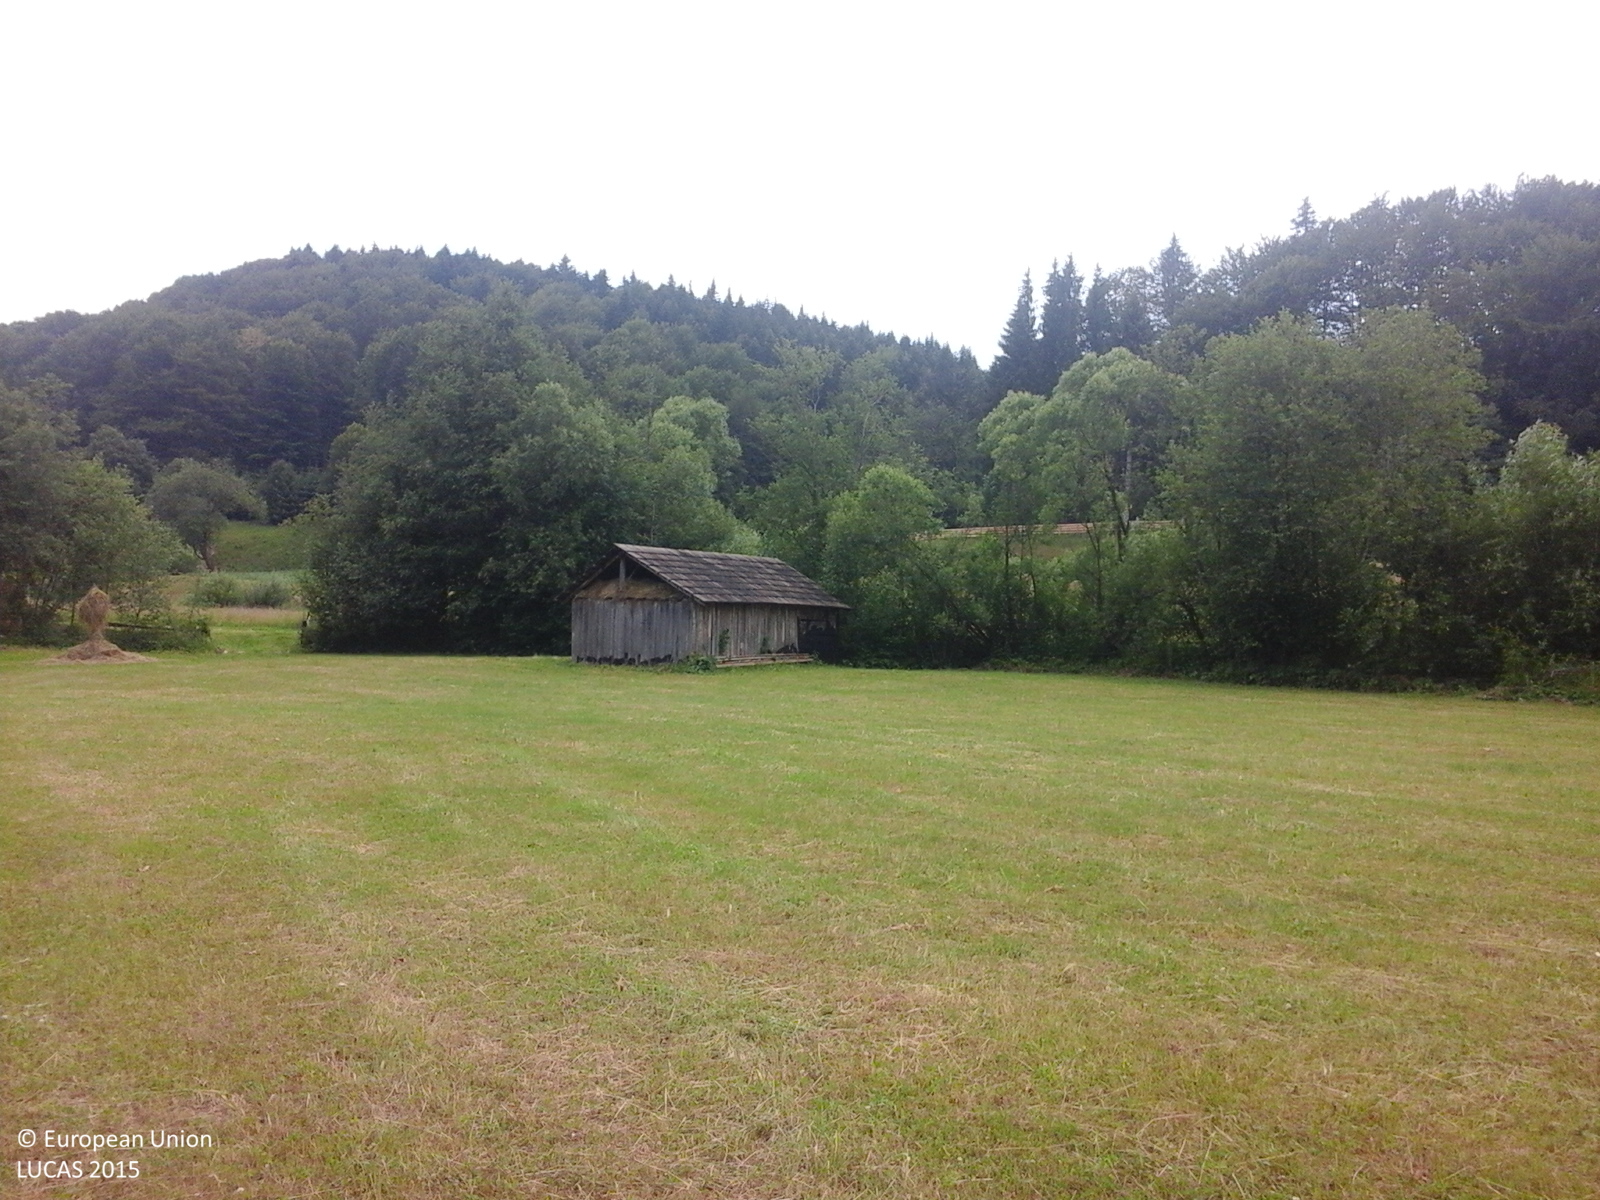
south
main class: Grassland
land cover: Grassland without tree/shrub cover
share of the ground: > 75 %
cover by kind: herbaceous plants 100 %
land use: Agriculture (excluding fallow land and kitchen gardens)
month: June
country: RO
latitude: 47.6228
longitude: 25.8127
